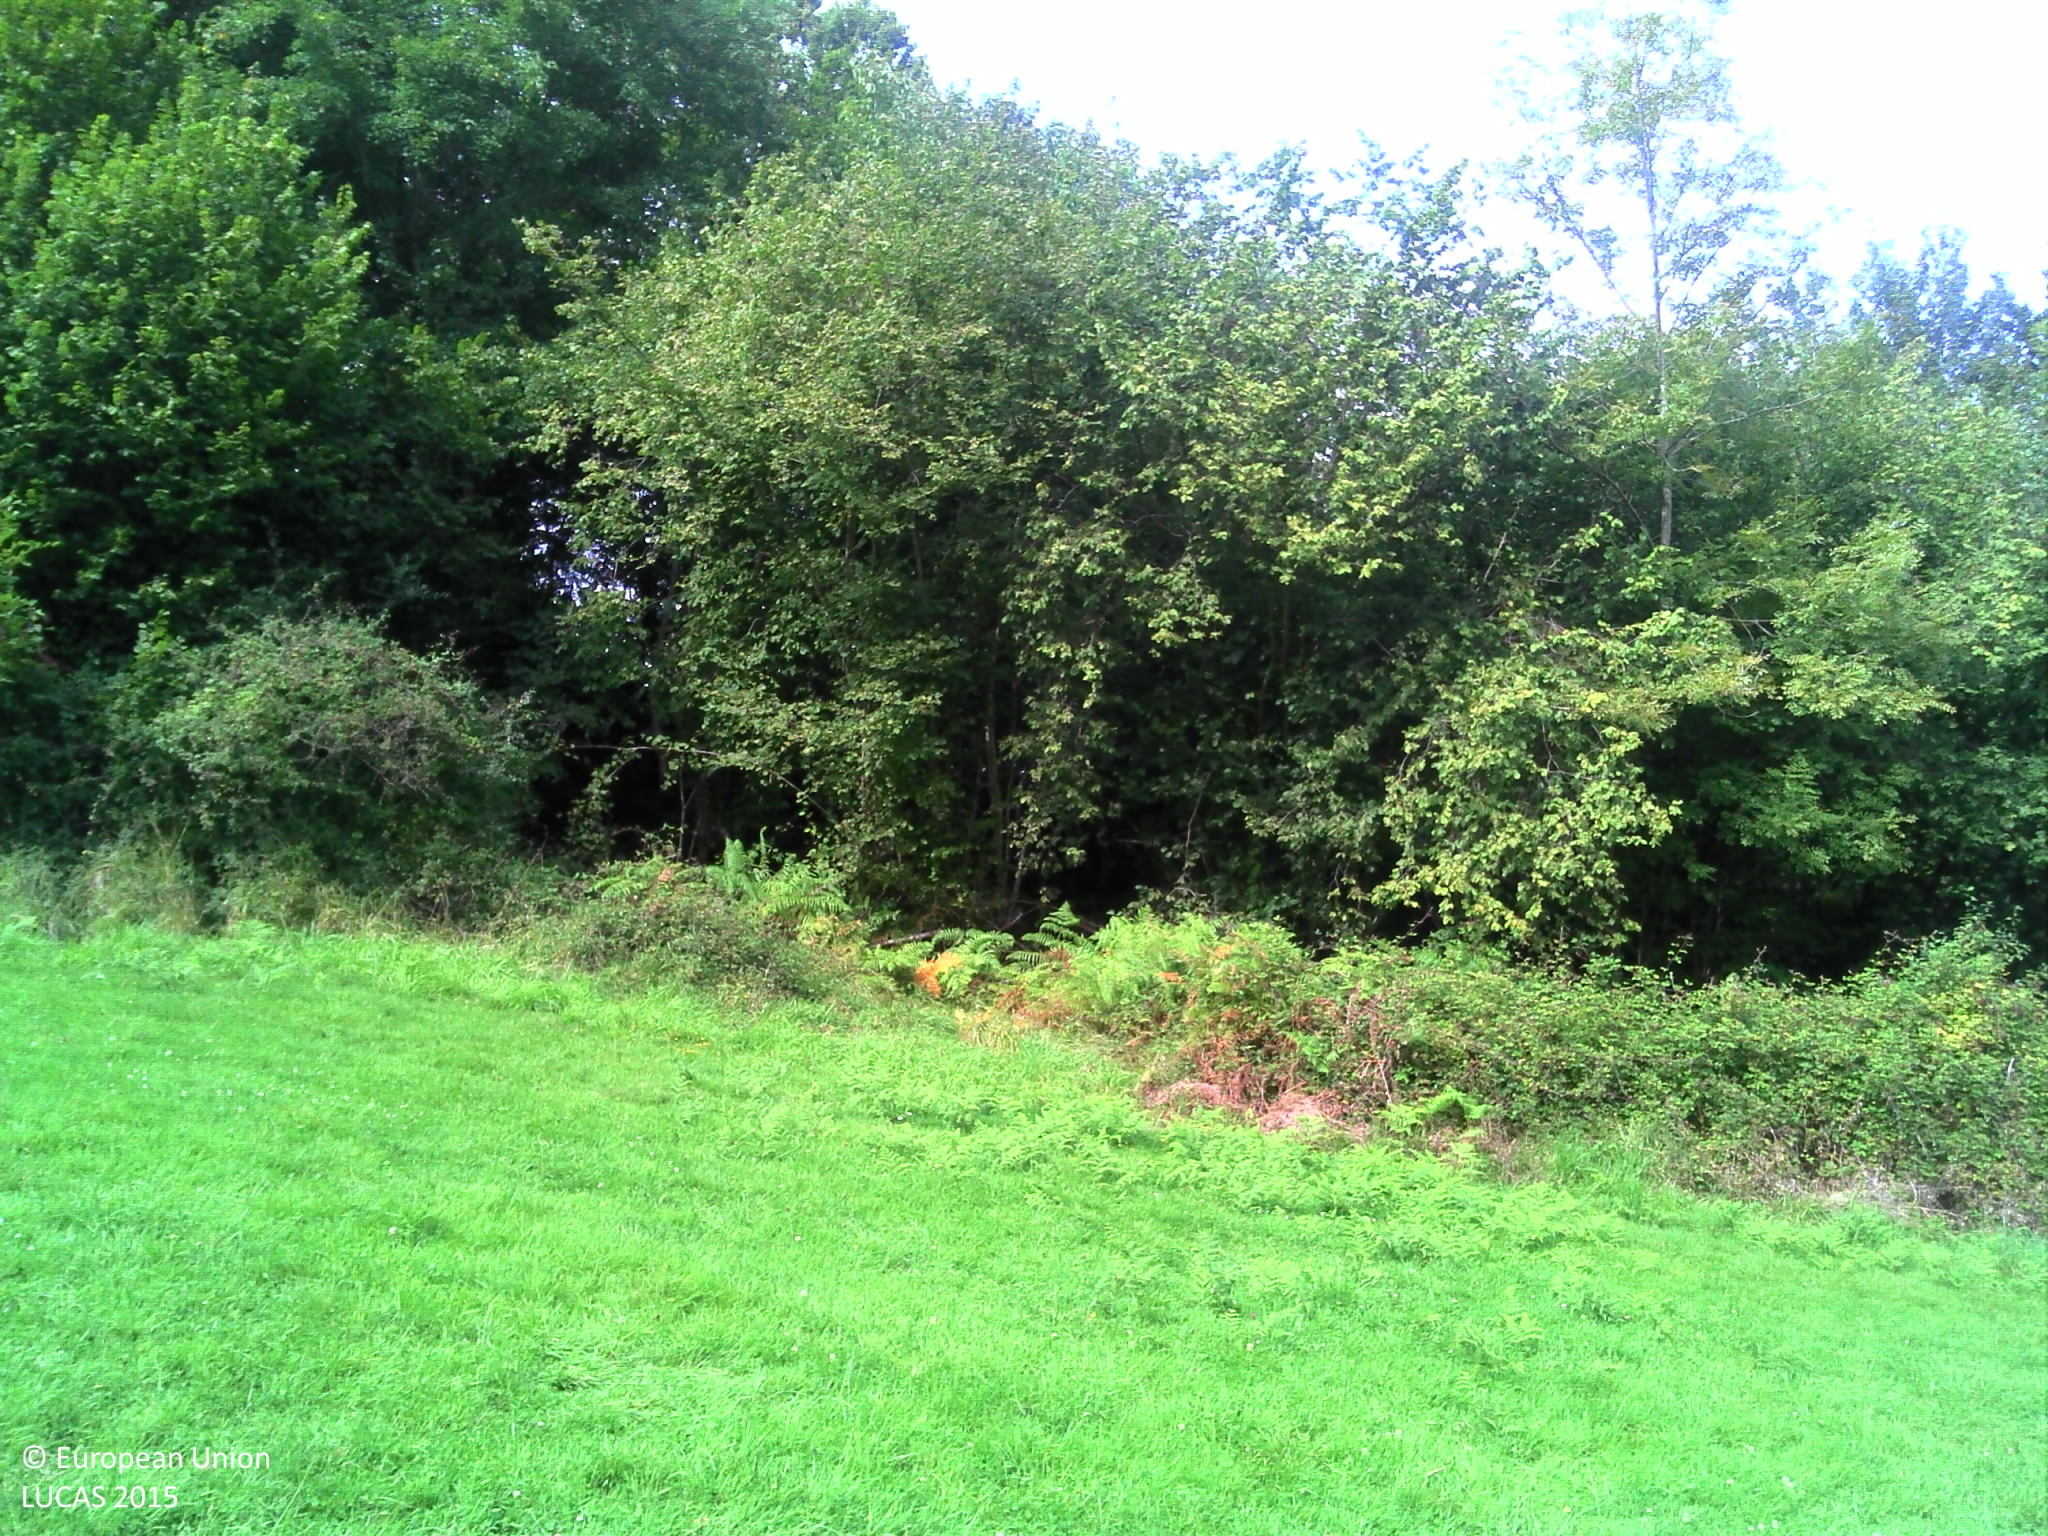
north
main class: Grassland
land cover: Grassland without tree/shrub cover
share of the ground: > 75 %
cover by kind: herbaceous plants 100 %
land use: Agriculture (excluding fallow land and kitchen gardens)
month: September
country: FR
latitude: 43.1615
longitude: -1.0189
